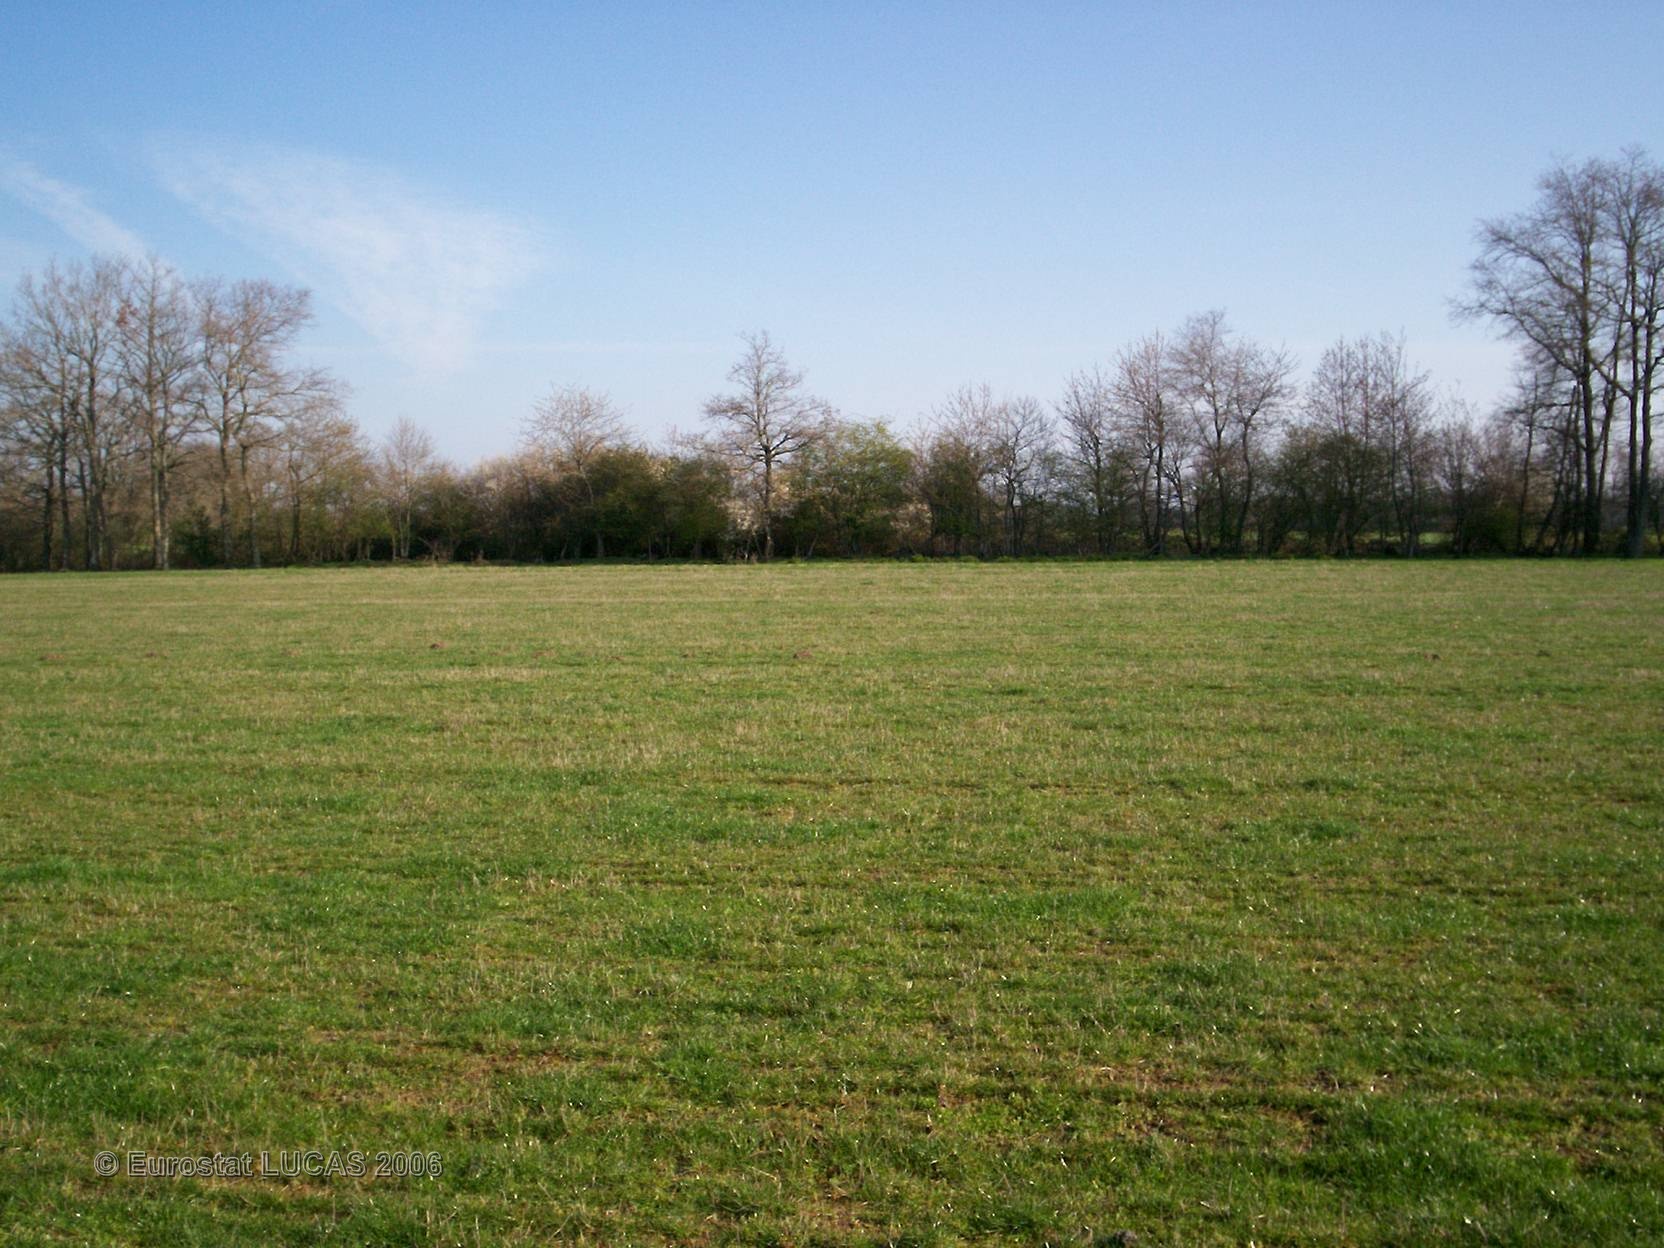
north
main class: Grassland
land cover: Grassland without tree/shrub cover
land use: Agriculture (excluding fallow land and kitchen gardens)
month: April
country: FR
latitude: 46.3230
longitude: 1.0908
